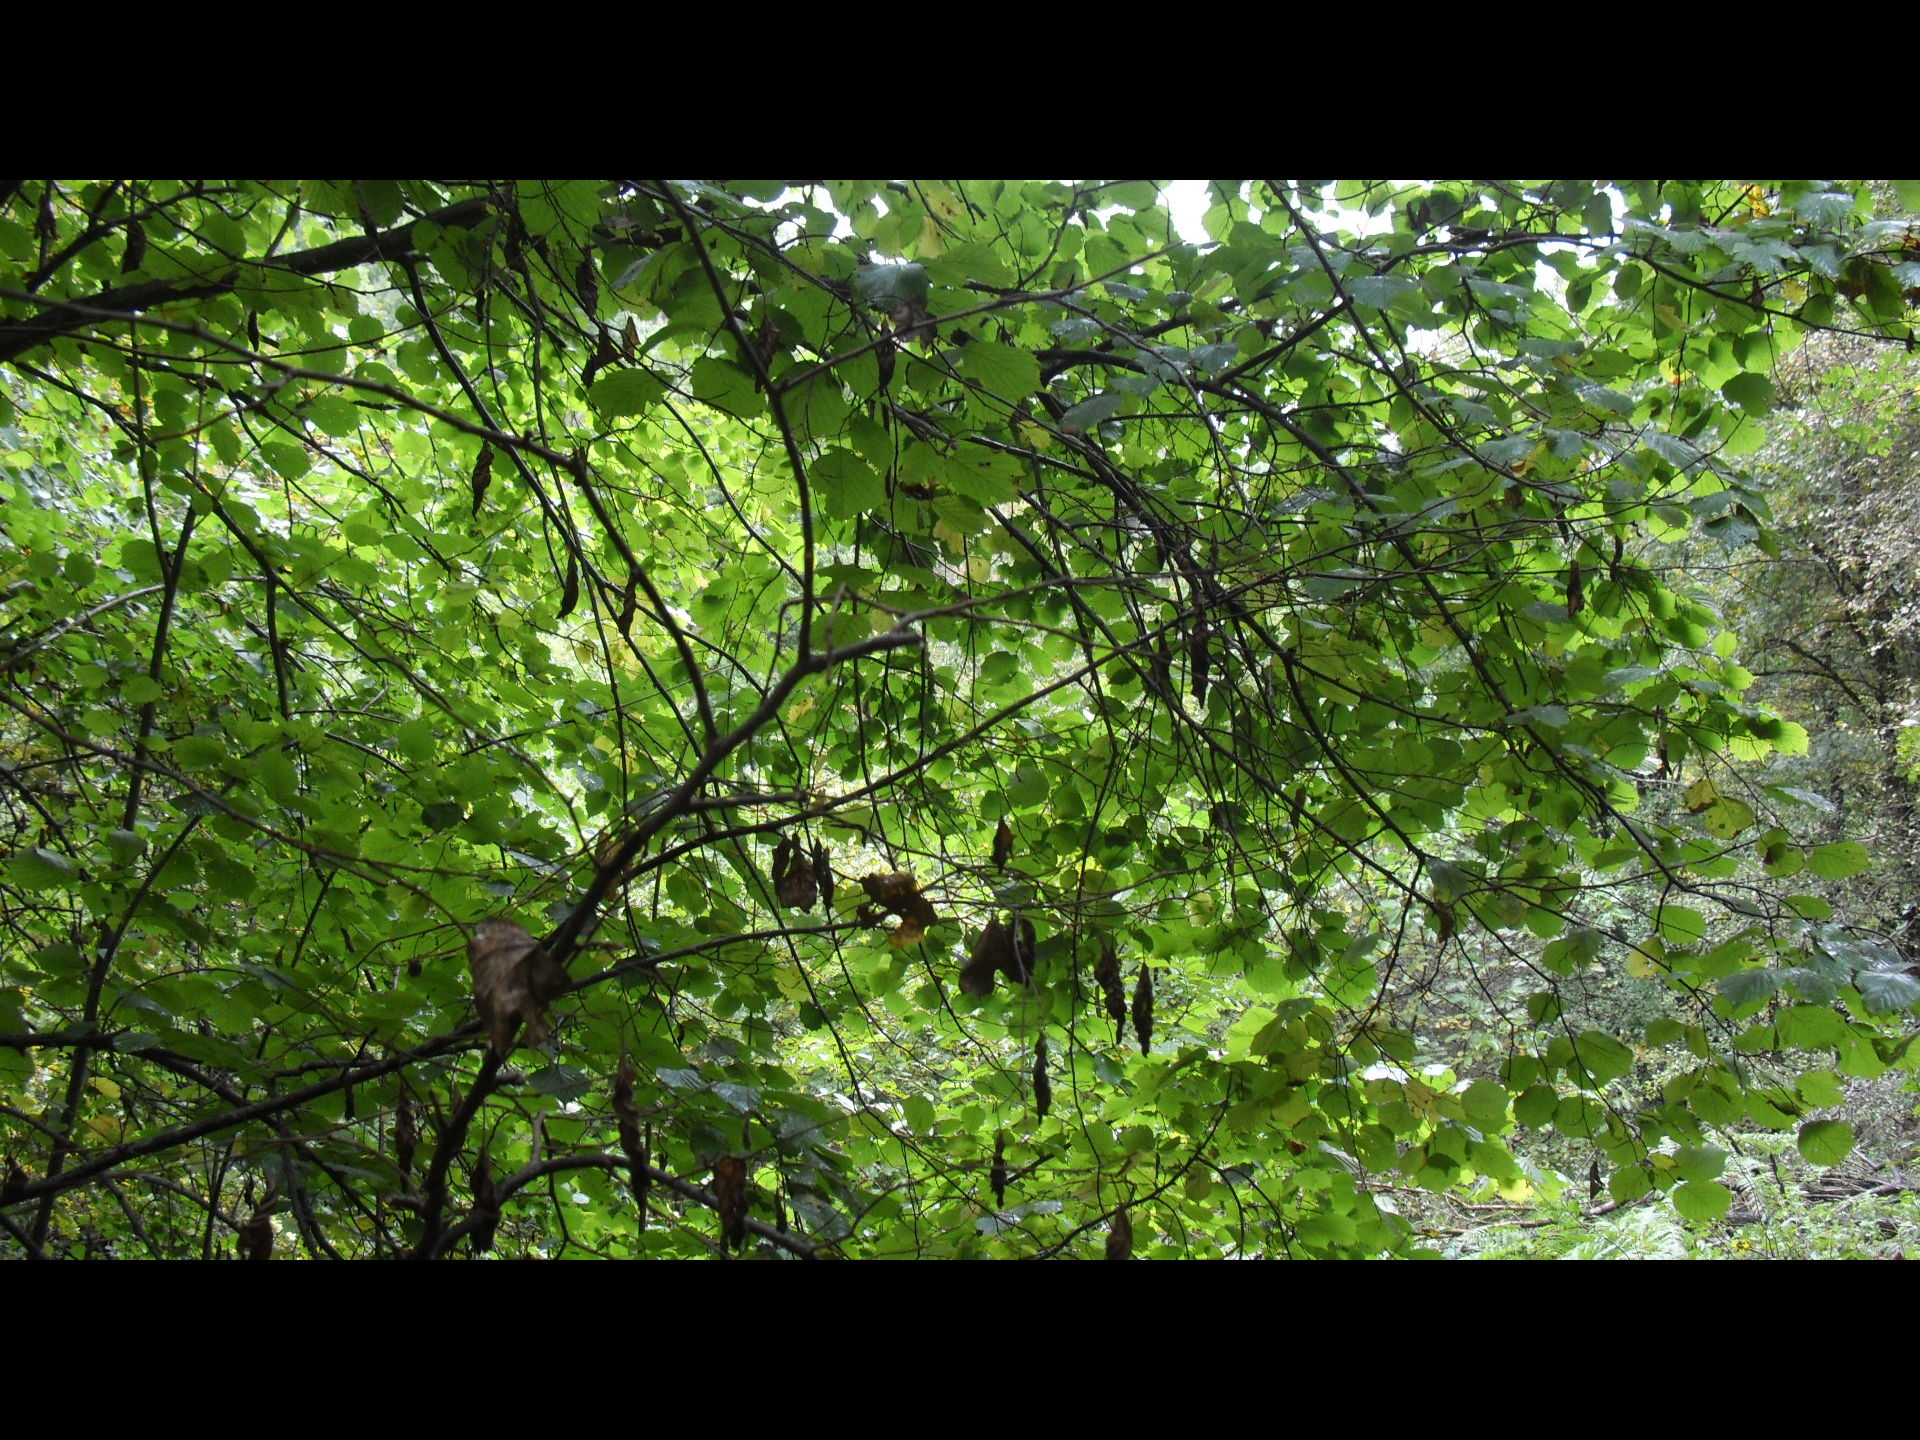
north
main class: Woodland
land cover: Broadleaved woodland
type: mesophytic deciduous forest
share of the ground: > 75 %
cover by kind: broadleaved forest trees 100 %
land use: Forestry
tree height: > 5 m
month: October
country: BG
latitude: 43.2814
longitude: 22.9366
